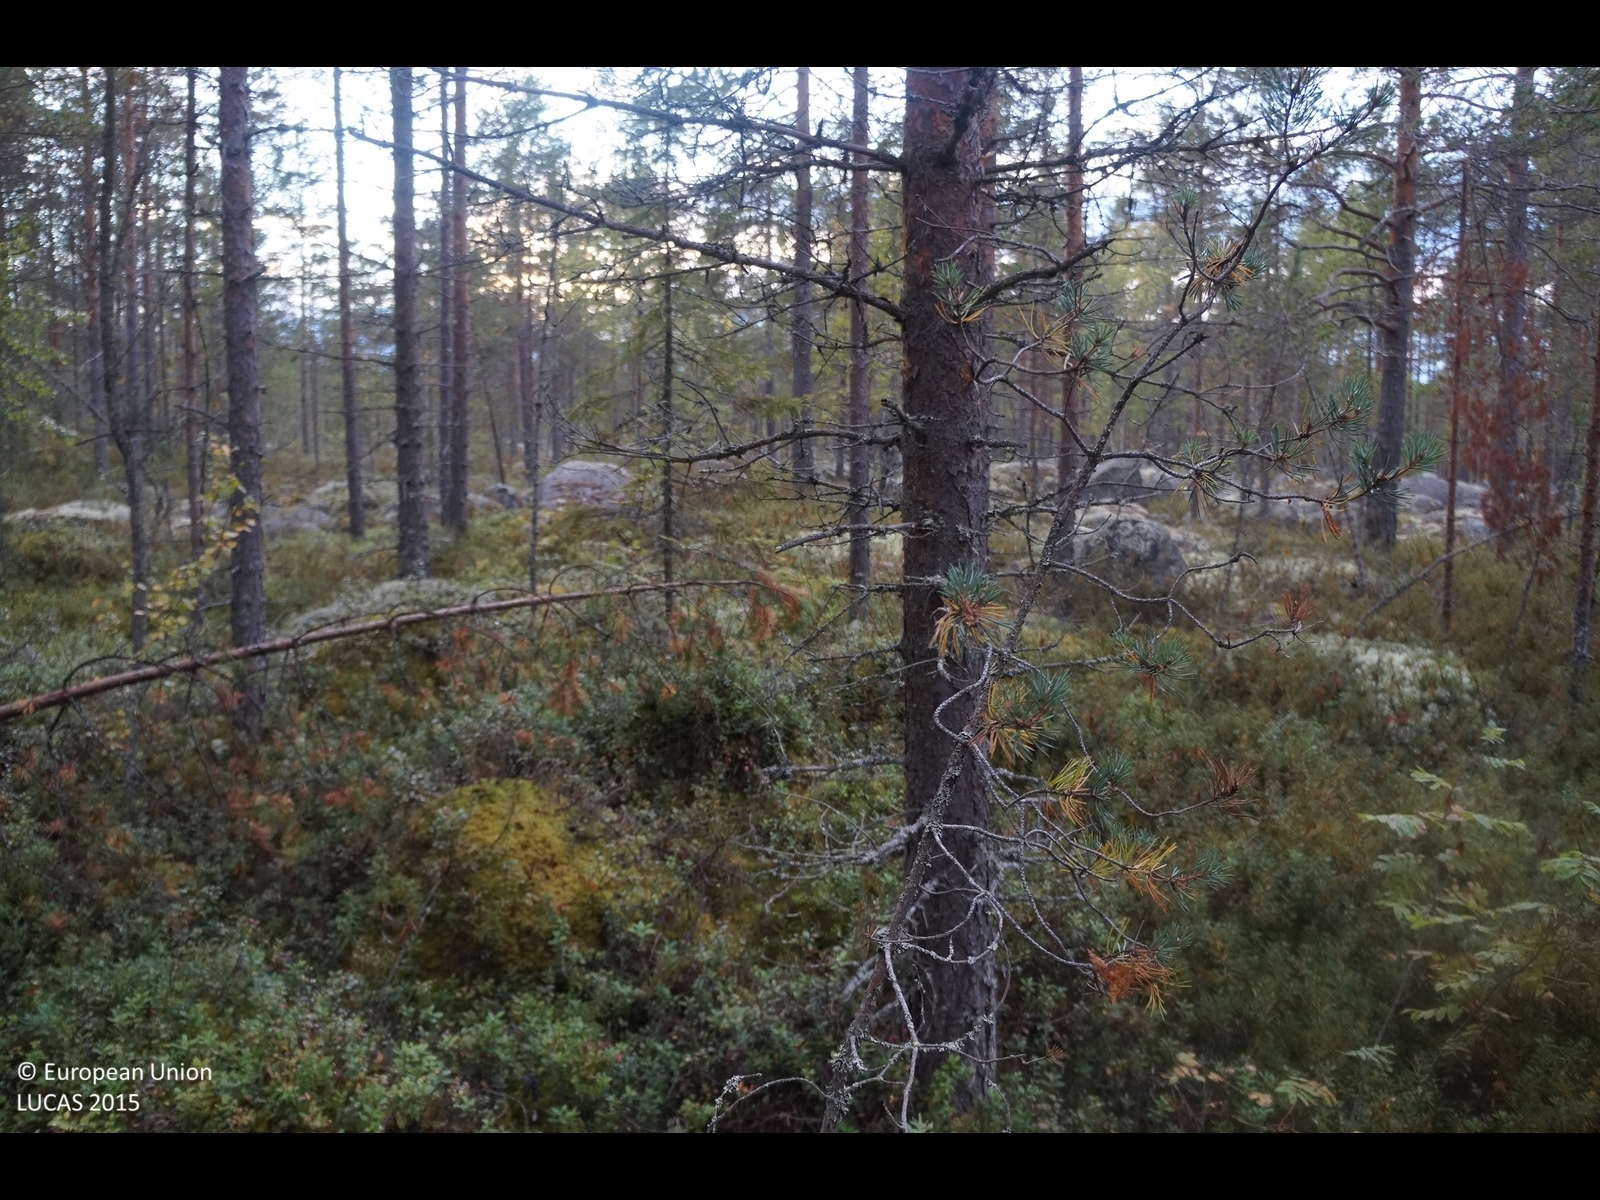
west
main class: Woodland
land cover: Pine dominated coniferous woodland
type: boreal forest
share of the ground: 50 - 75 %
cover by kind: coniferous forest trees 50 %, shrubs 20 %, lichens and mosses 15 %, consolidated bare surface 15 %
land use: Forestry
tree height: > 5 m
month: September
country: FI
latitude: 63.8991
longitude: 24.4371
